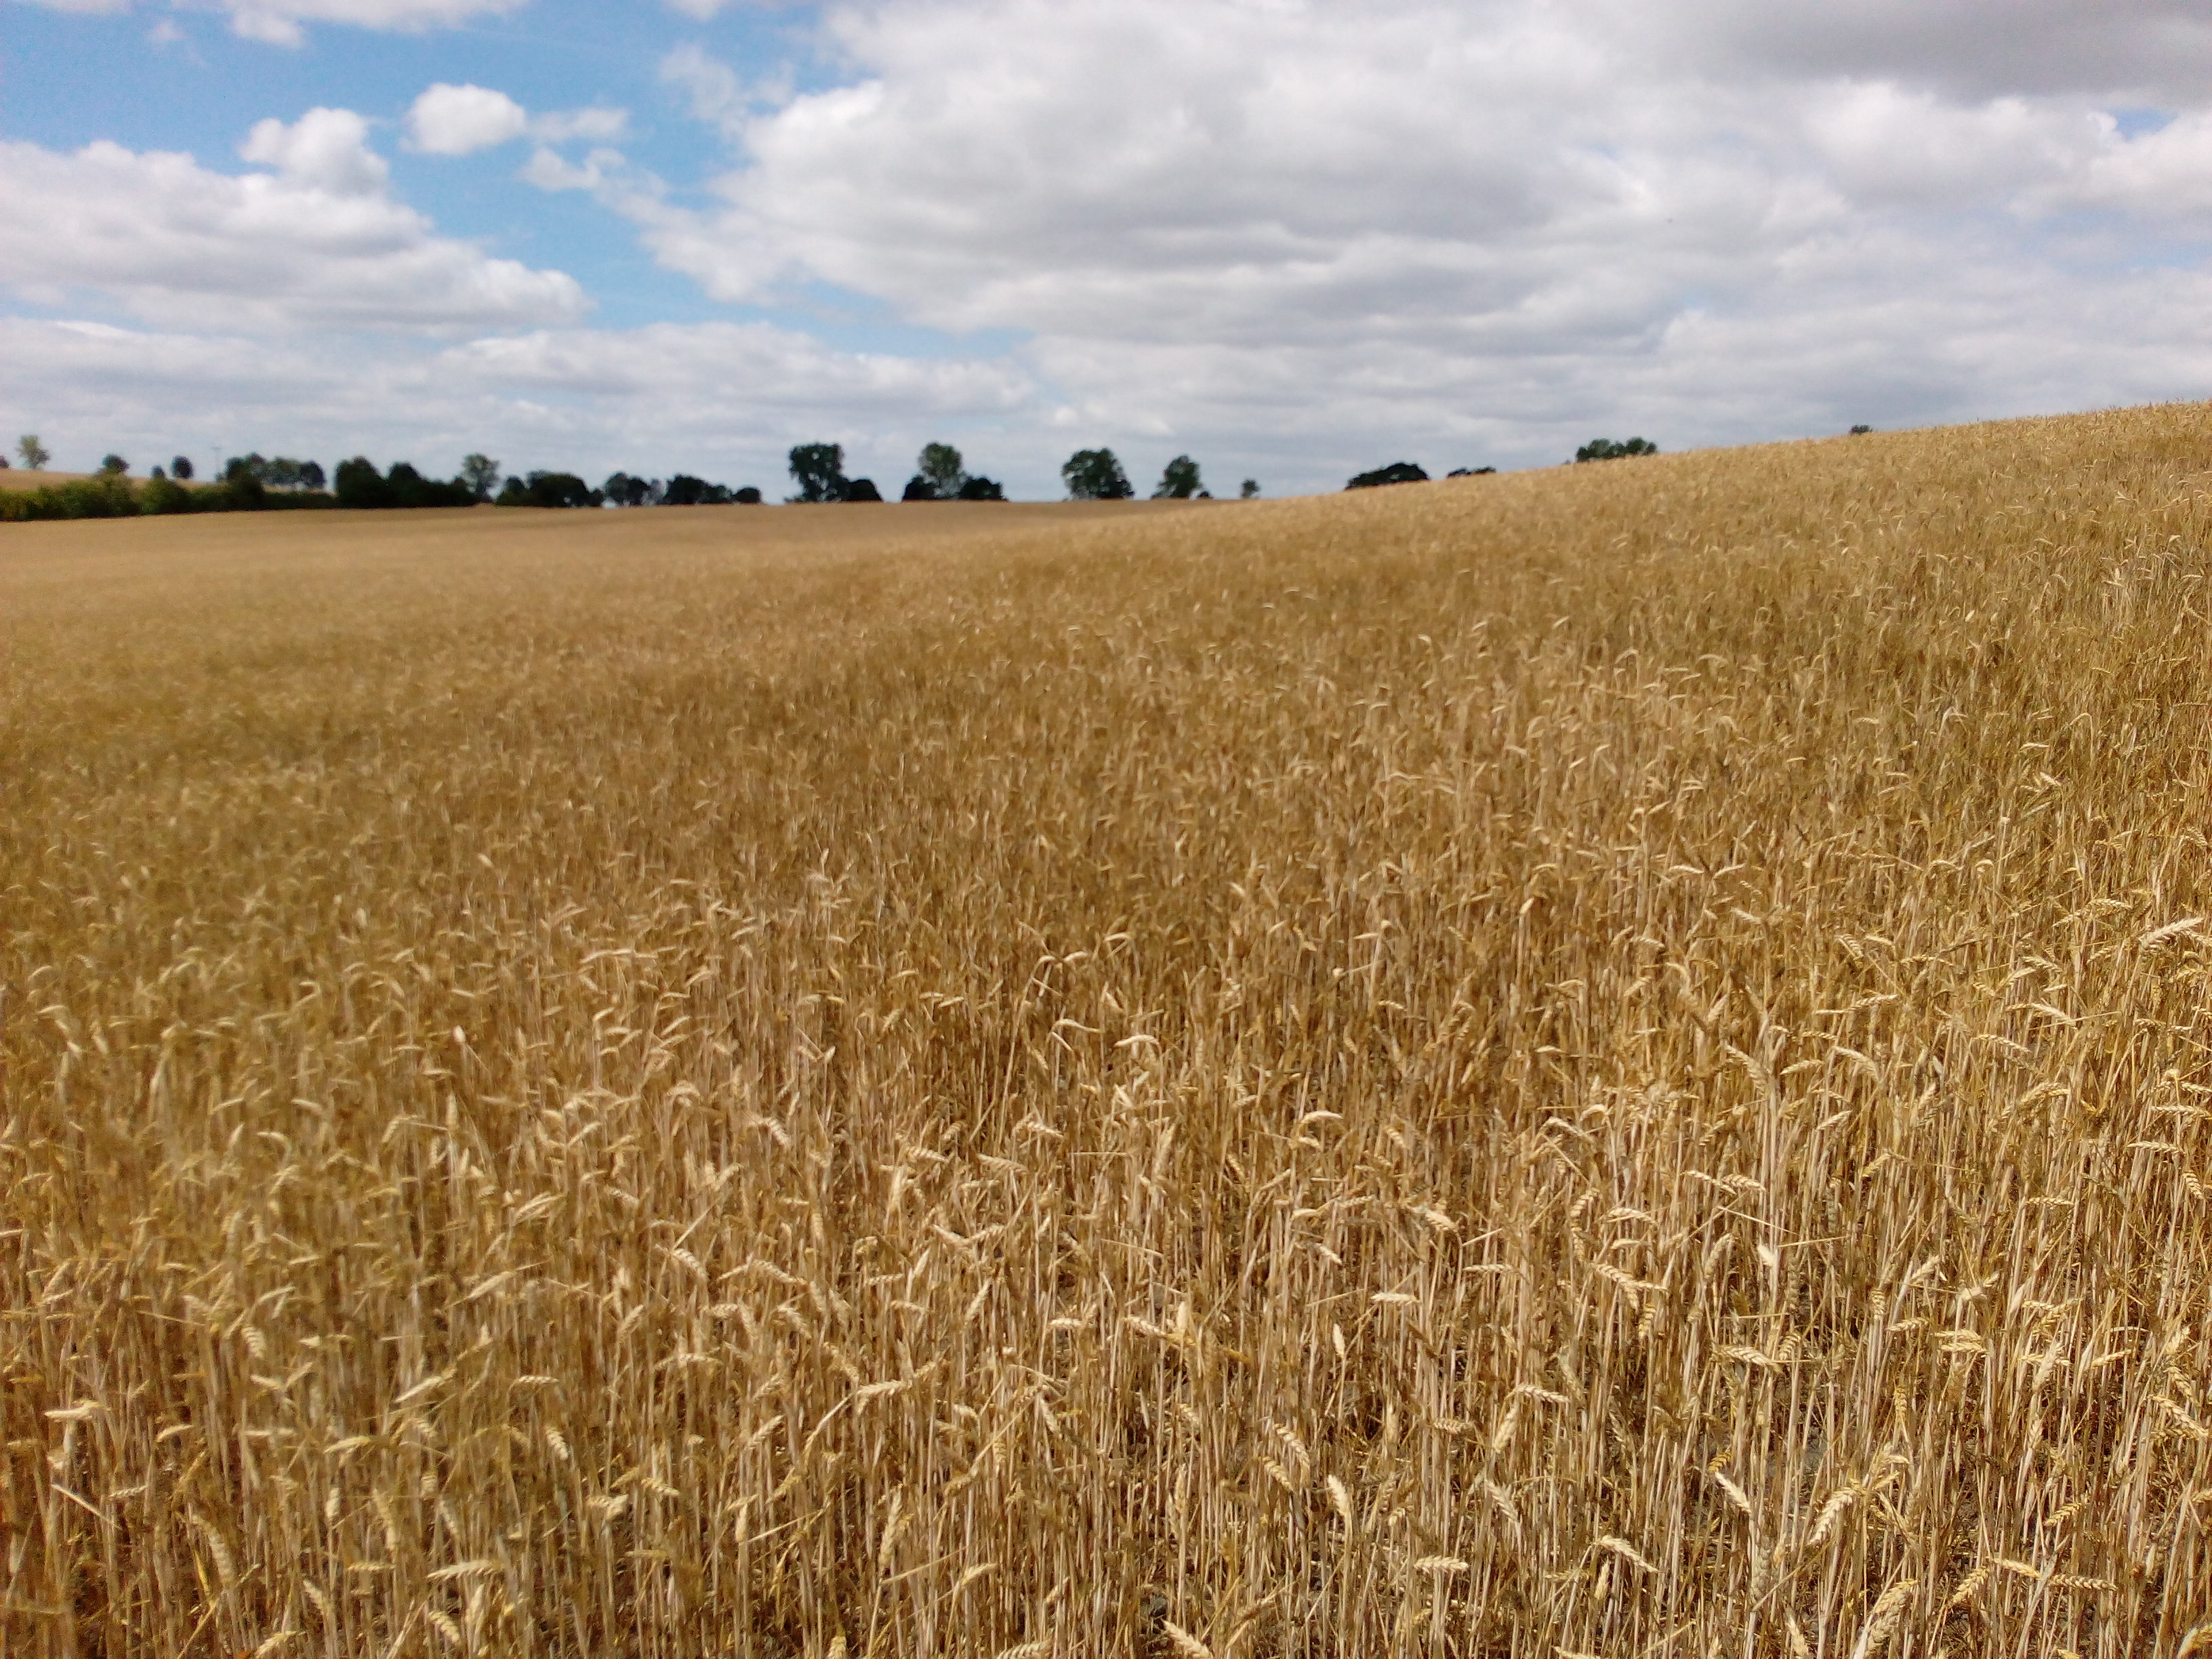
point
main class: Cropland
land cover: Common wheat
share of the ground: > 75 %
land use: Agriculture (excluding fallow land and kitchen gardens)
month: July
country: DE
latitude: 51.1694
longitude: 10.9294
